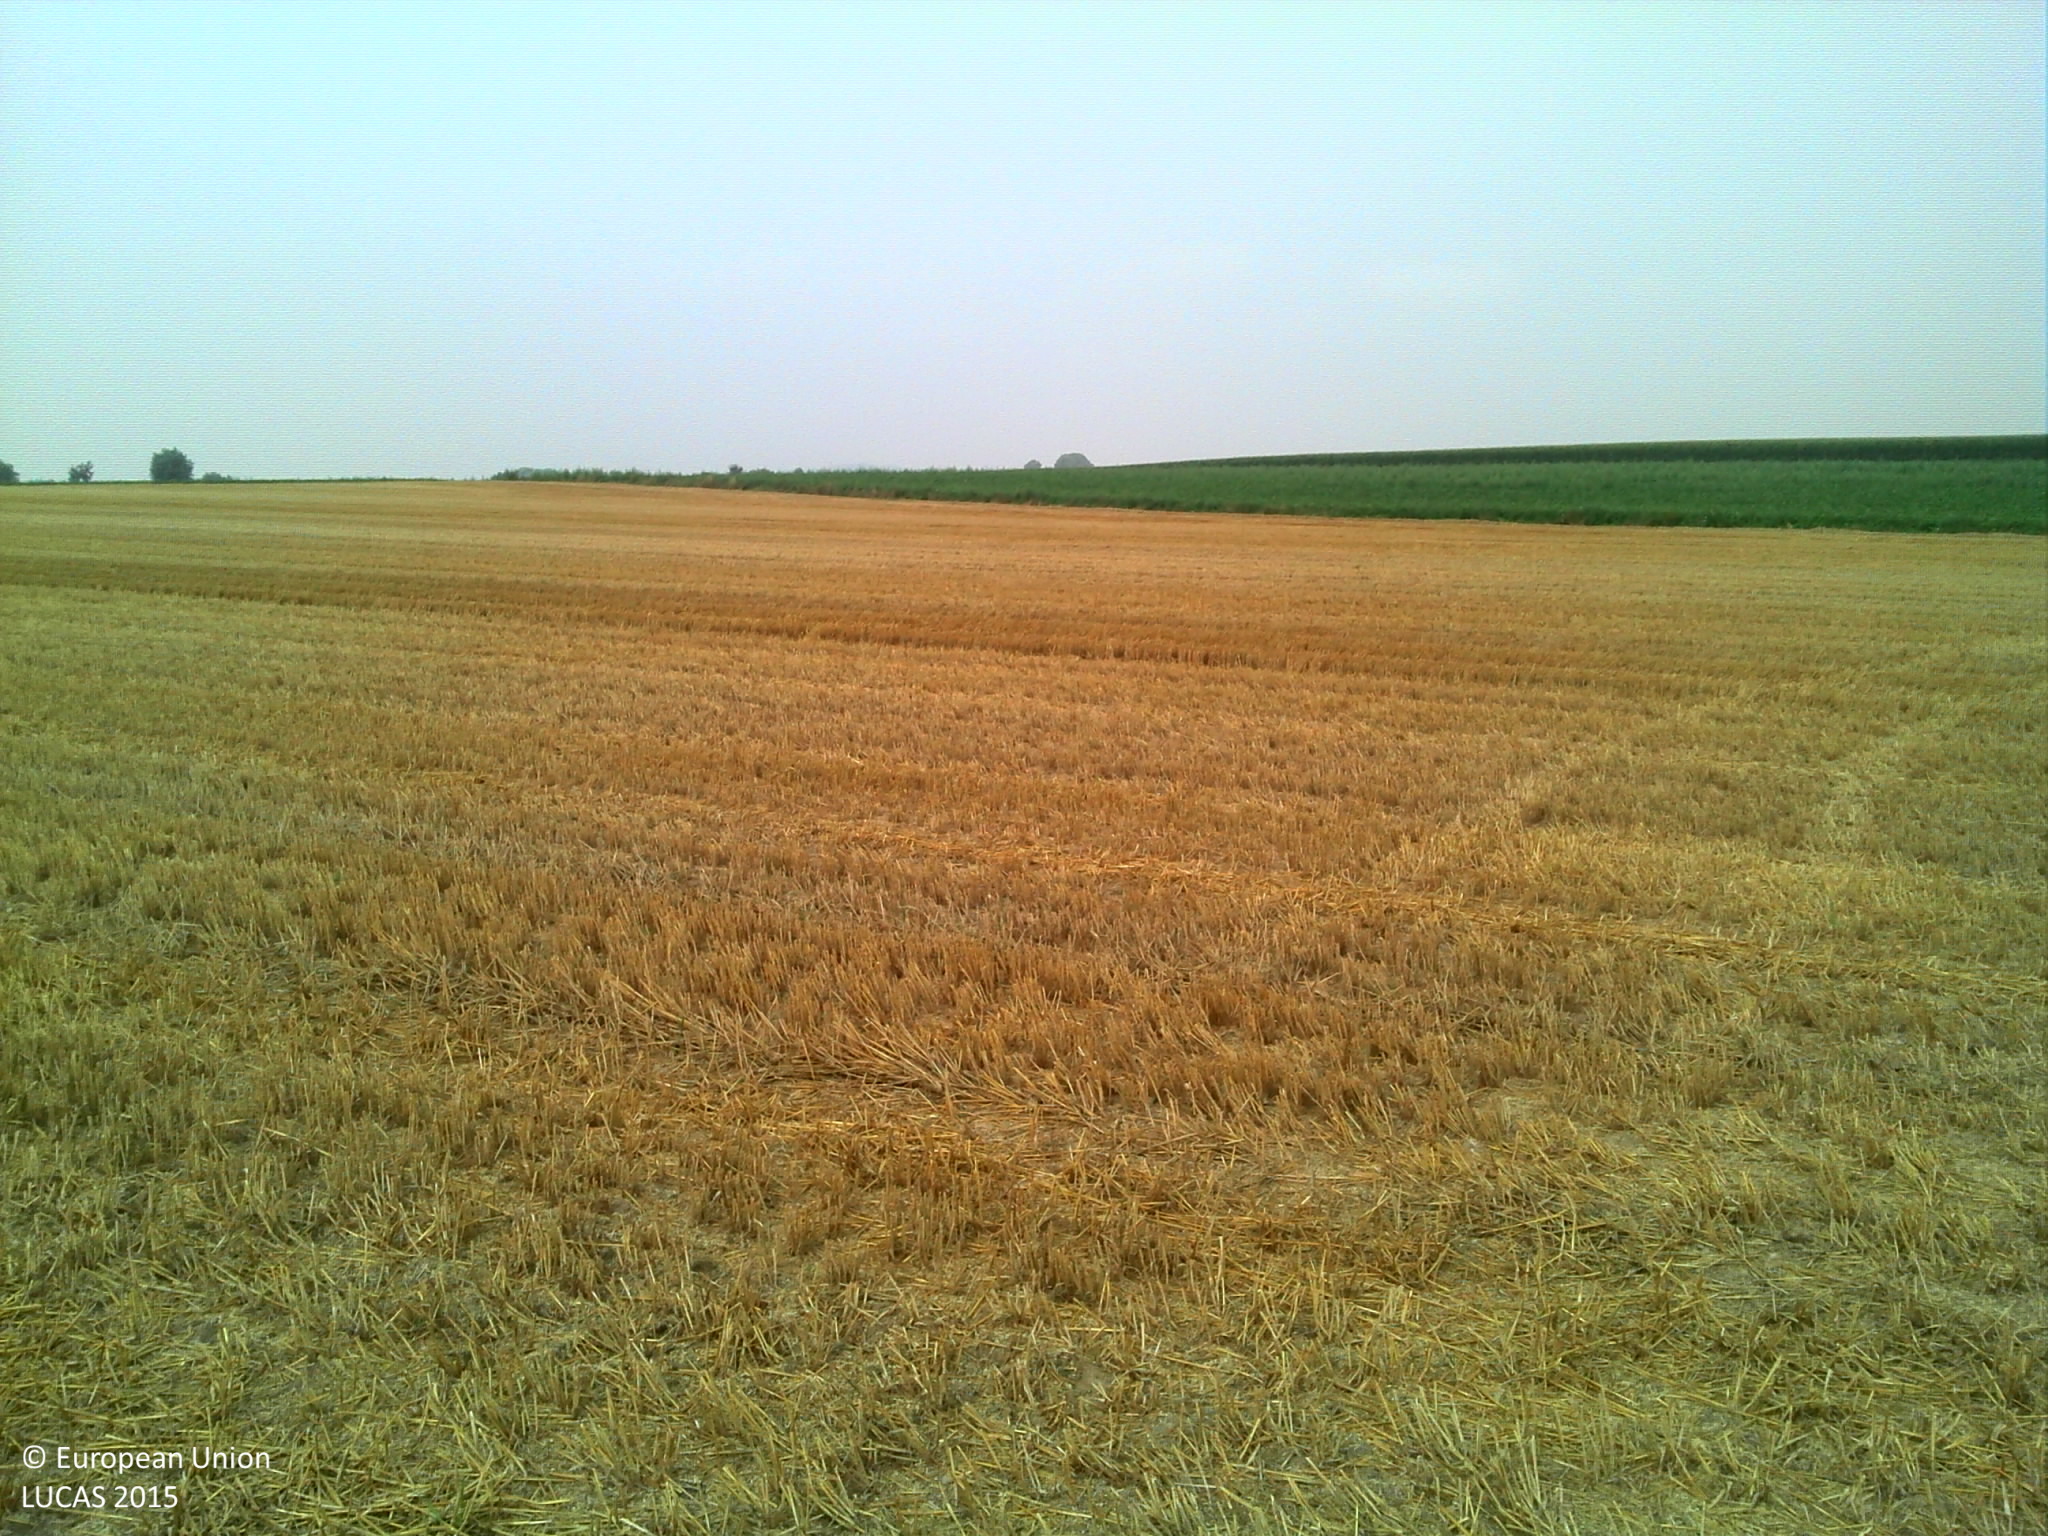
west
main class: Cropland
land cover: Common wheat
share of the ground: > 75 %
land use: Agriculture (excluding fallow land and kitchen gardens)
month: August
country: BE
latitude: 50.6645
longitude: 3.4700
